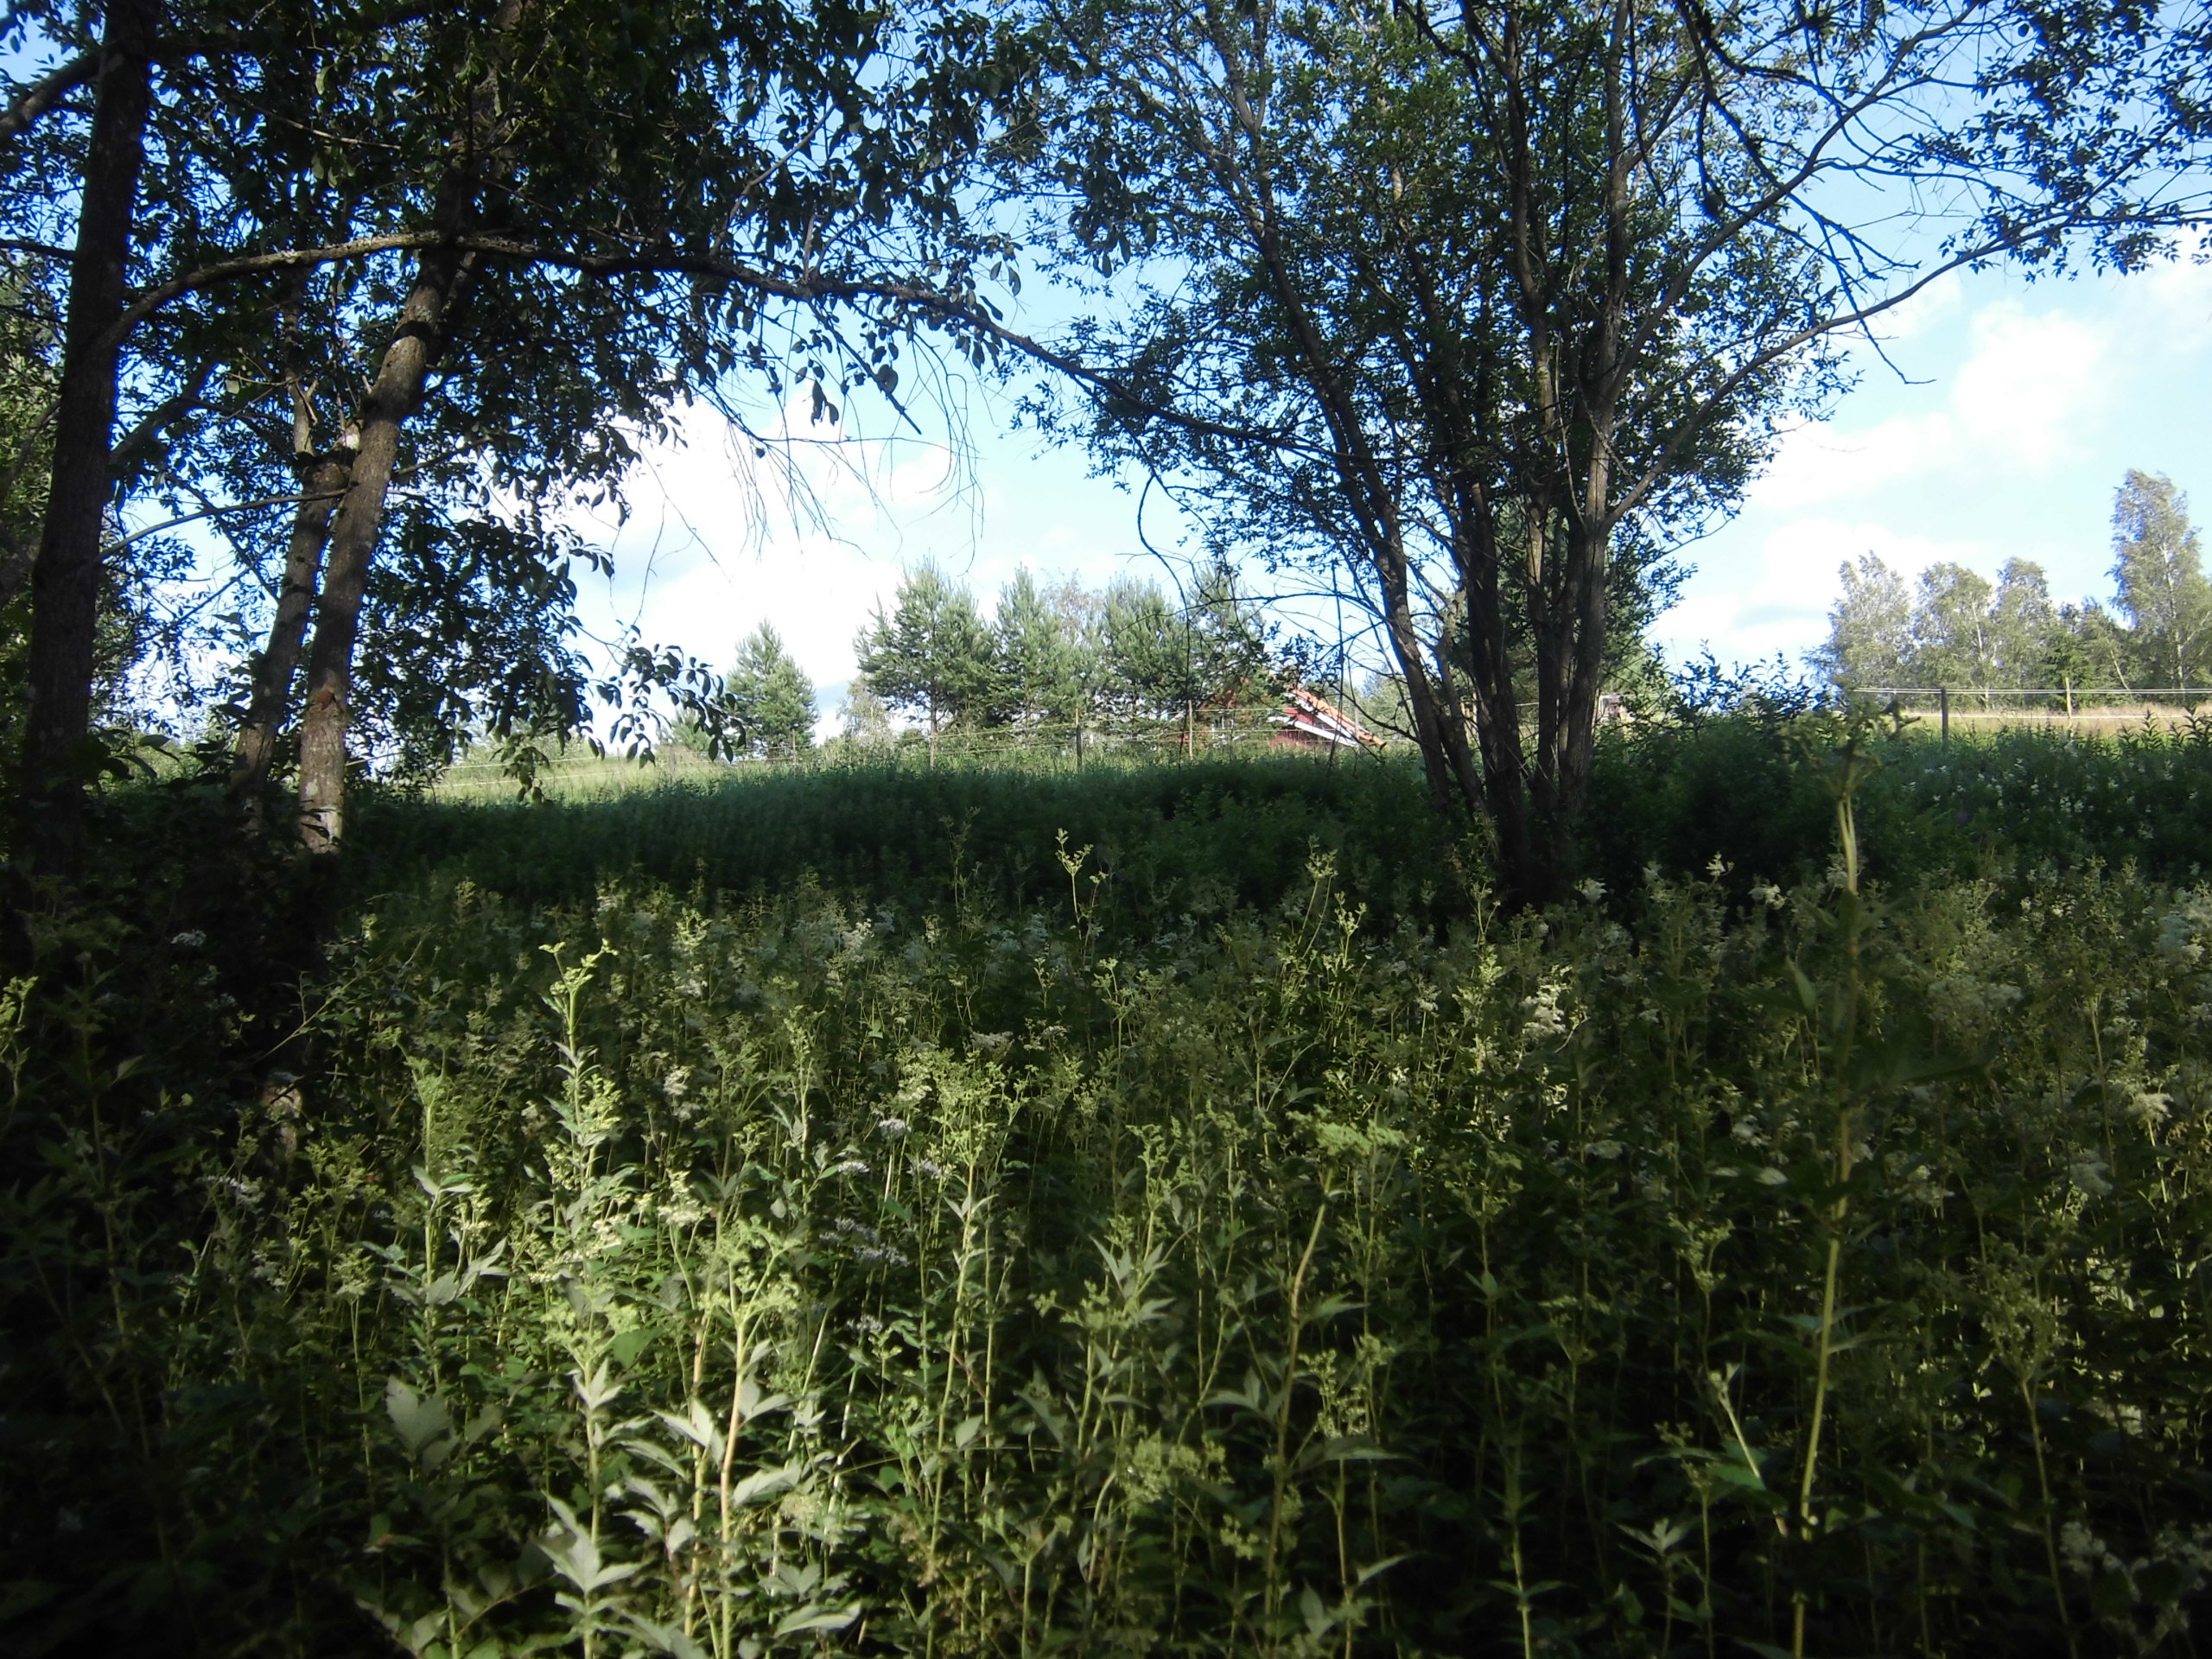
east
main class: Woodland
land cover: Broadleaved woodland
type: boreal forest
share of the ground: 50 - 75 %
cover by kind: broadleaved forest trees 60 %, herbaceous plants 35 %, shrubs 5 %
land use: Forestry
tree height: > 5 m
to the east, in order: Broadleaved woodland; Spontaneously vegetated surfaces; Fences; Grassland without tree/shrub cover; Fences; Groves; Artificial constructions in urban areas; Grassland with sparse tree/shrub cover; Electric lines; Grassland with sparse tree/shrub cover; Broadleaved woodland; Grassland with sparse tree/shrub cover
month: July
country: SE
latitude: 57.3824
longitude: 15.1363
